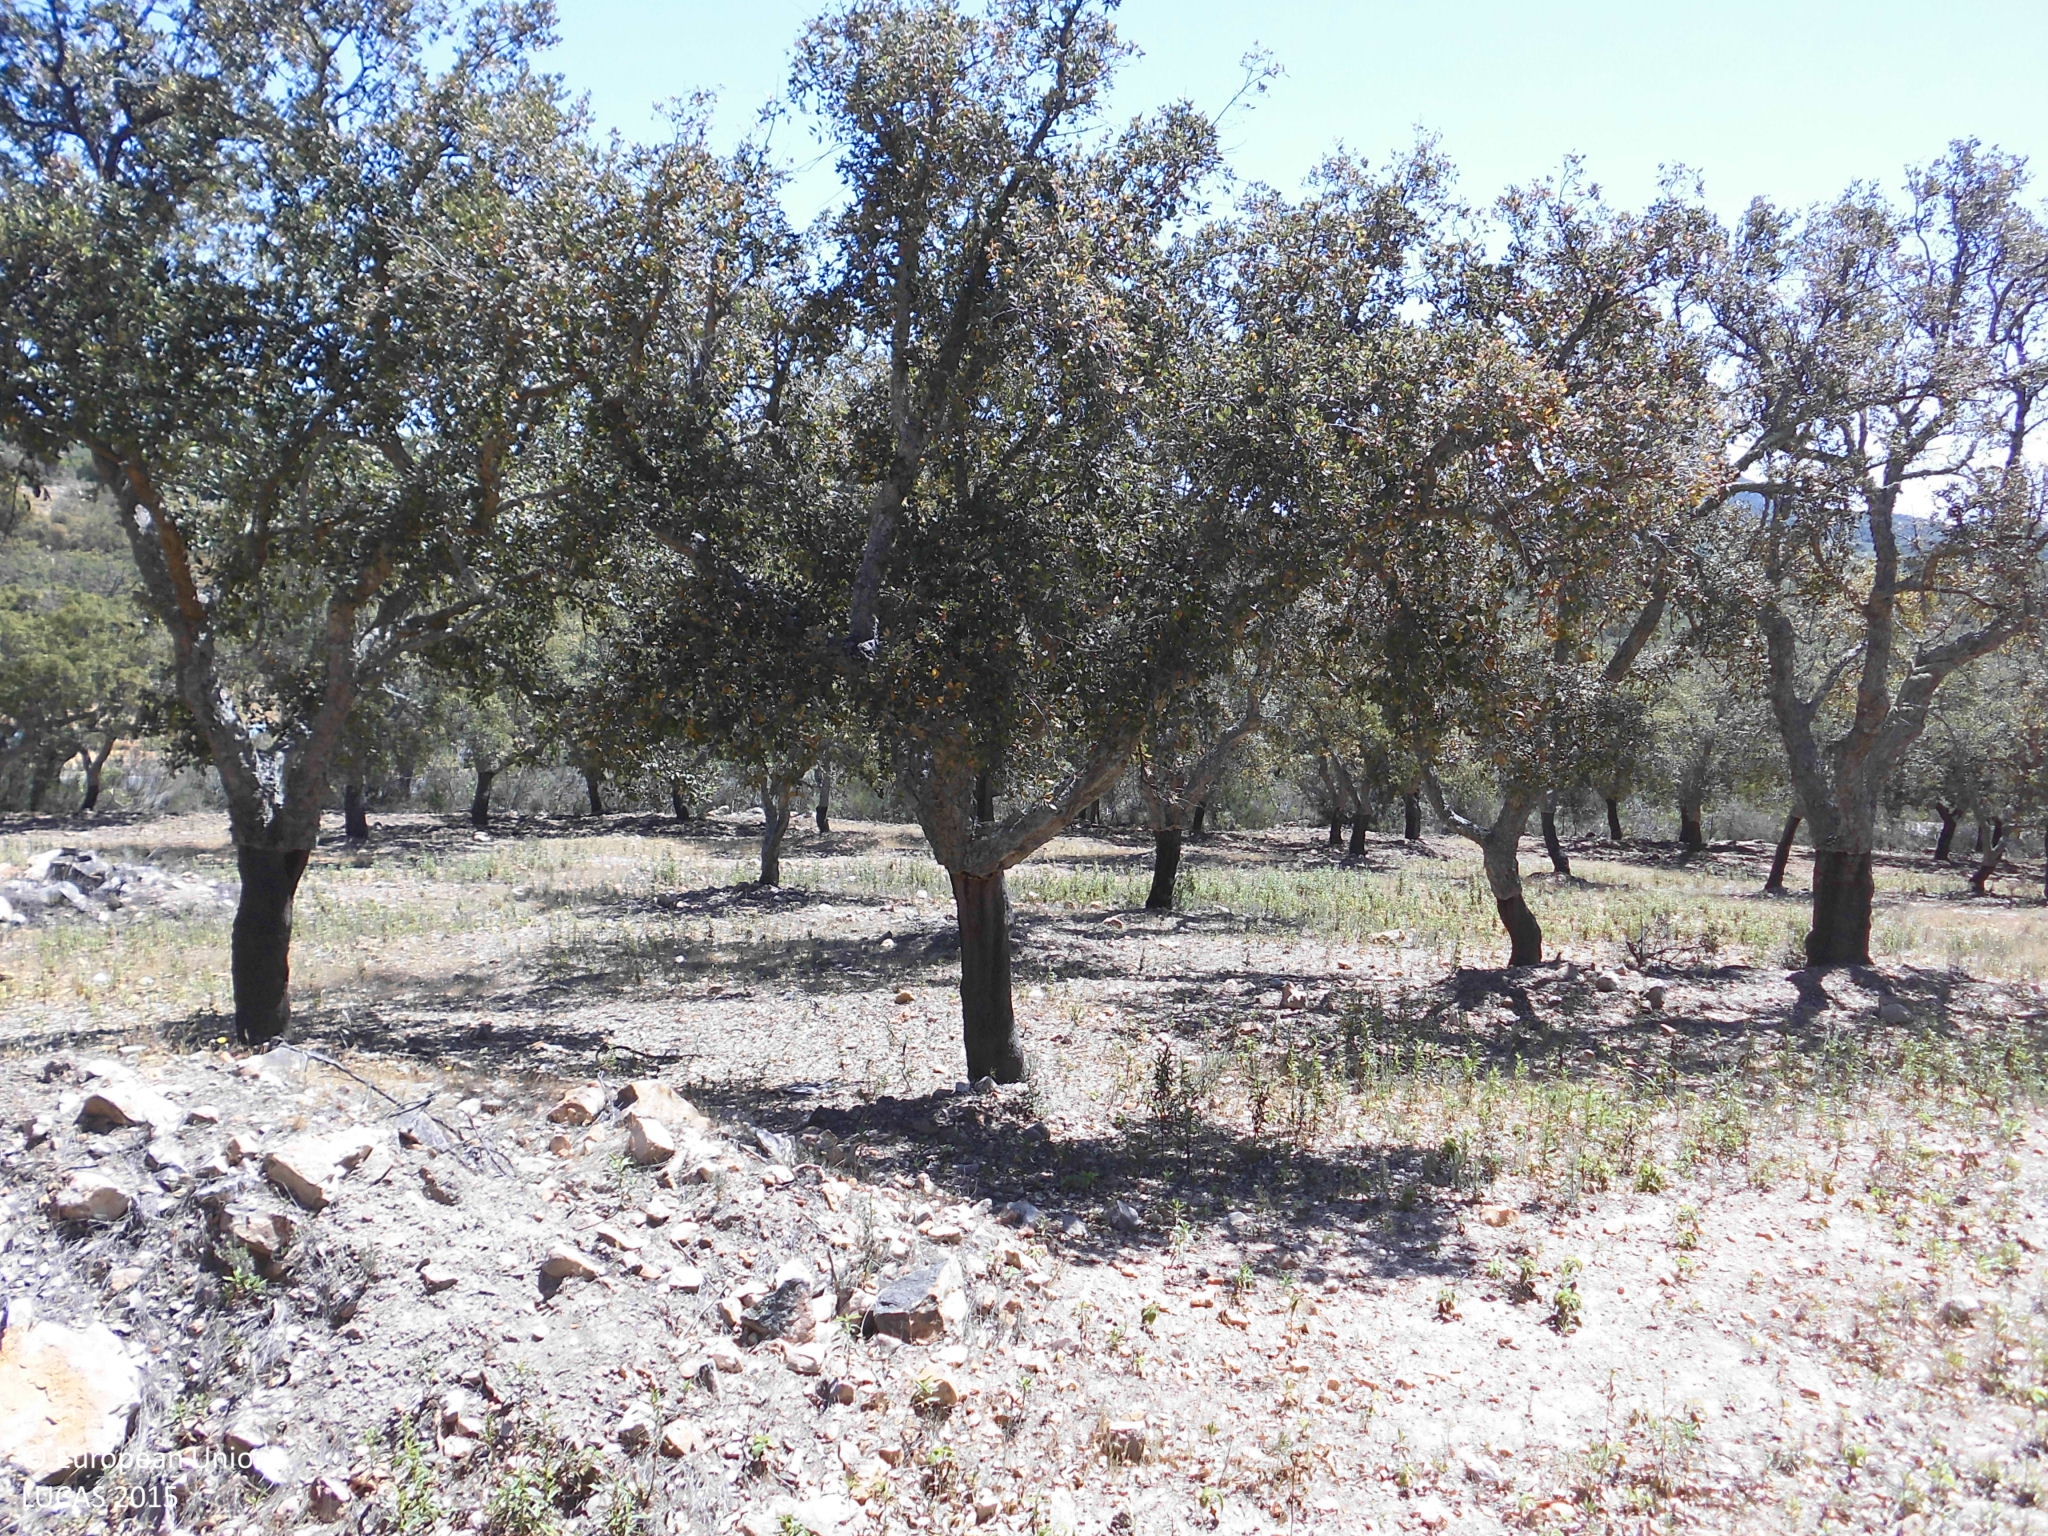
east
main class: Woodland
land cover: Broadleaved woodland
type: broadleaved evergreen forest
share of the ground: 25 - 50 %
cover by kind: broadleaved forest trees 60 %, unconsolidated bare surface 35 %, herbaceous plants 5 %
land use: Forestry
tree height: > 5 m
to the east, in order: Broadleaved woodland; Fences; Shruby margins; Paved roads, cycling and walking lanes; Shruby margins; Fences; Broadleaved woodland
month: May
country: ES
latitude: 39.4299
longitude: -7.0308
